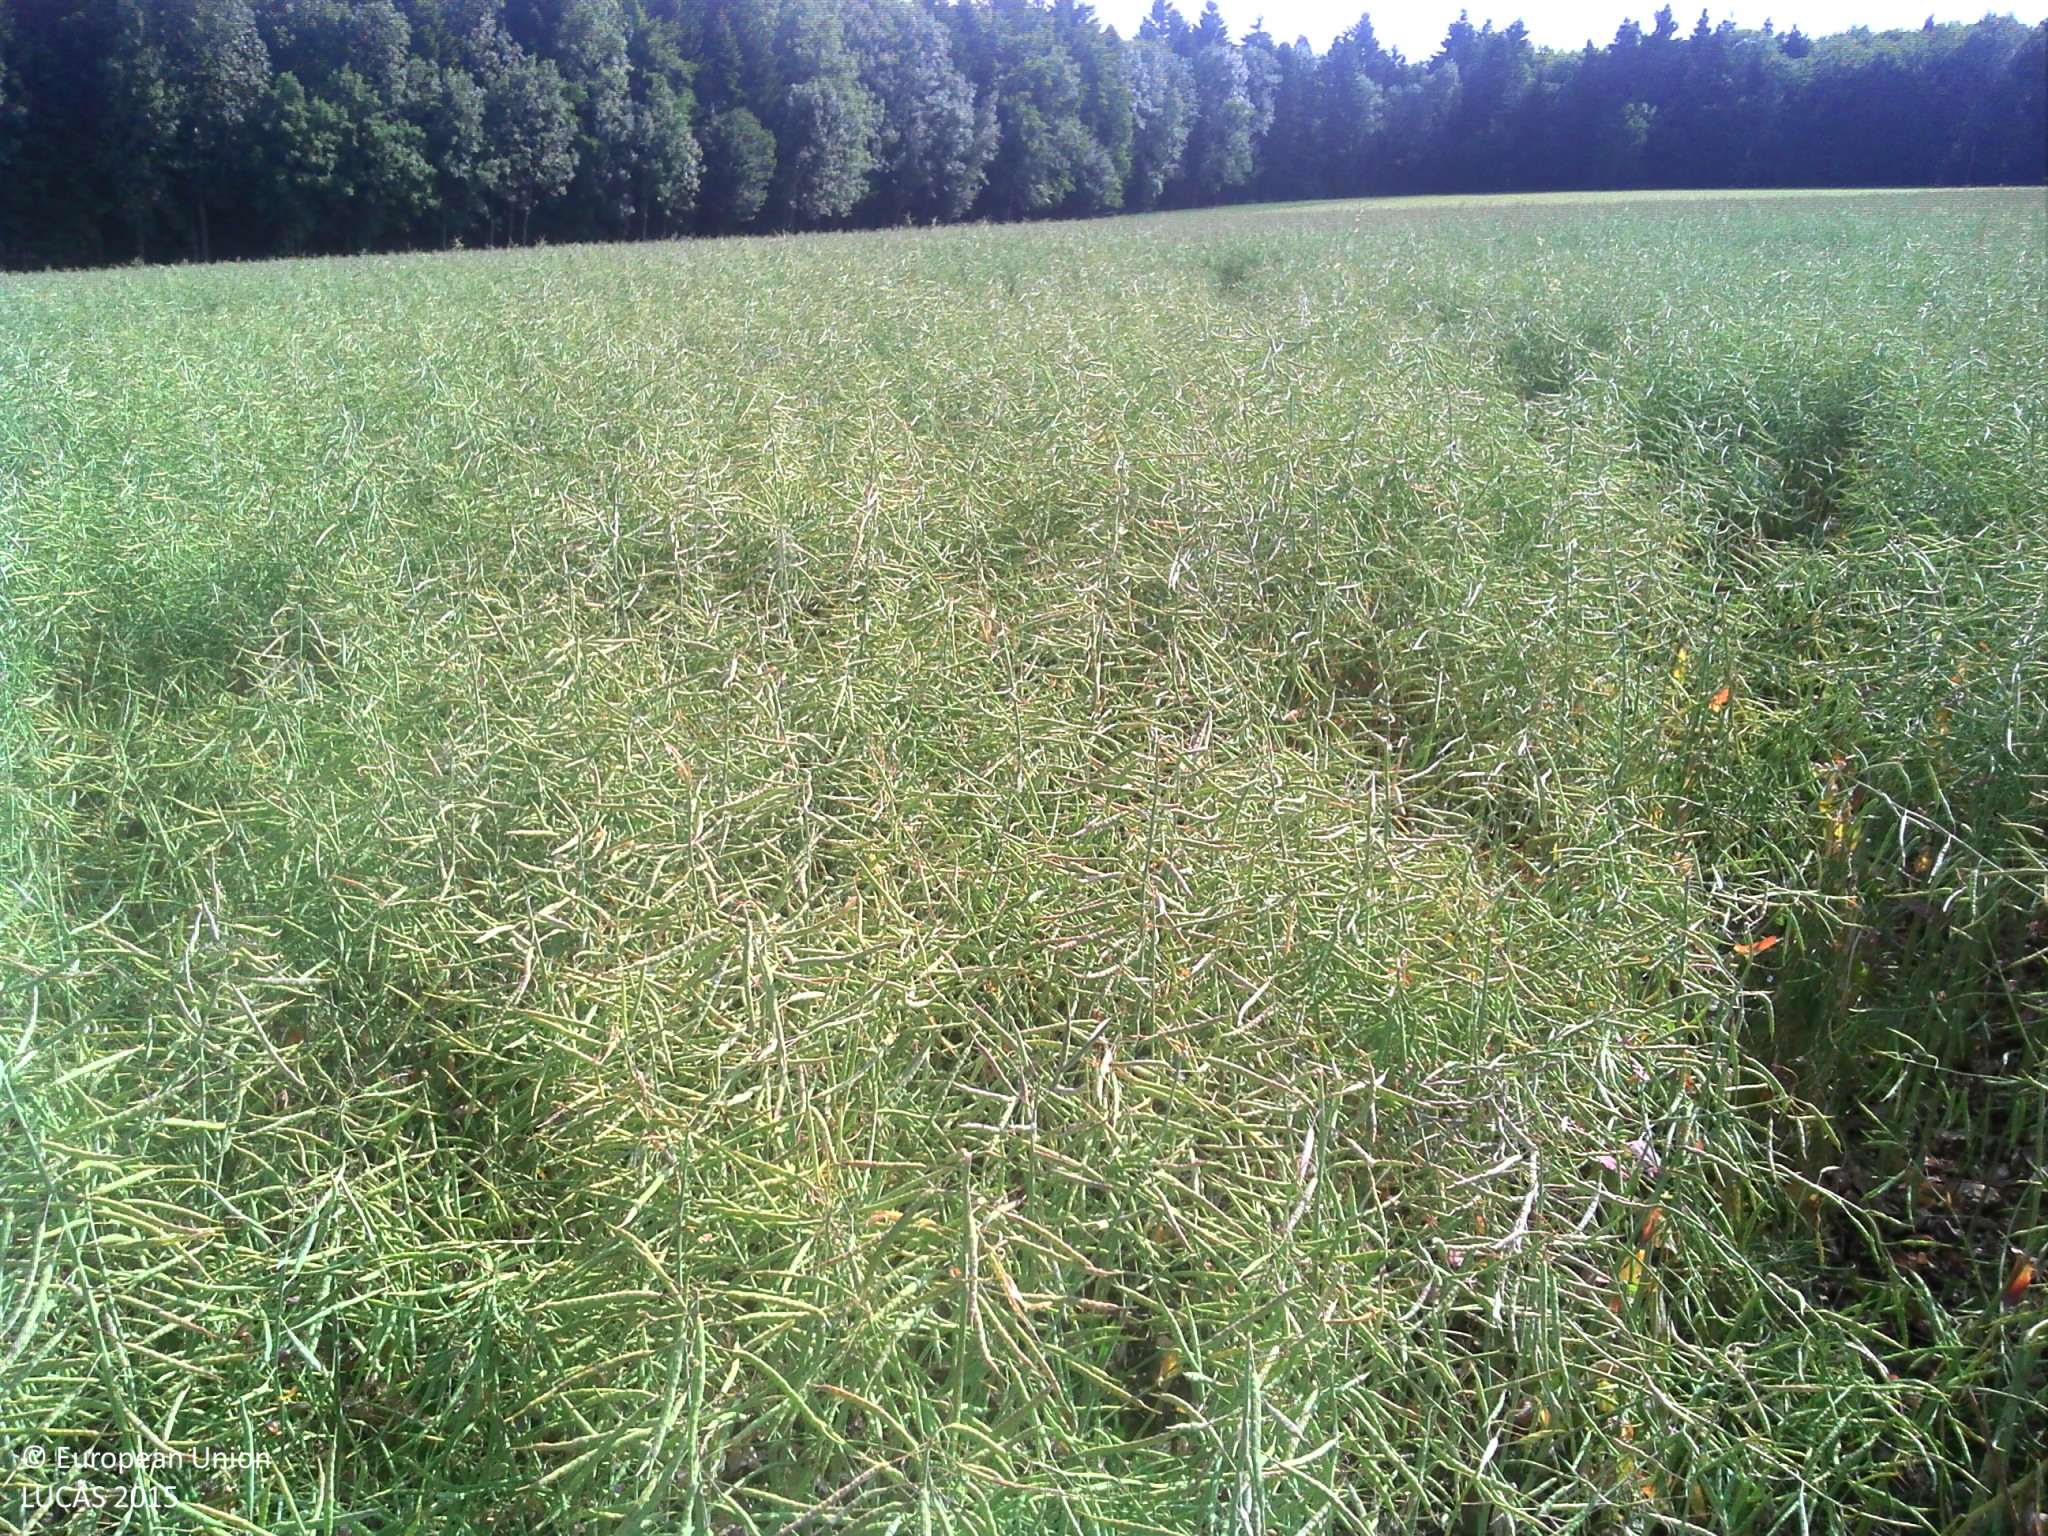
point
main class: Cropland
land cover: Rape and turnip rape
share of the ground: > 75 %
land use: Agriculture (excluding fallow land and kitchen gardens)
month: June
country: FR
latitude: 48.3034
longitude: 4.8889
